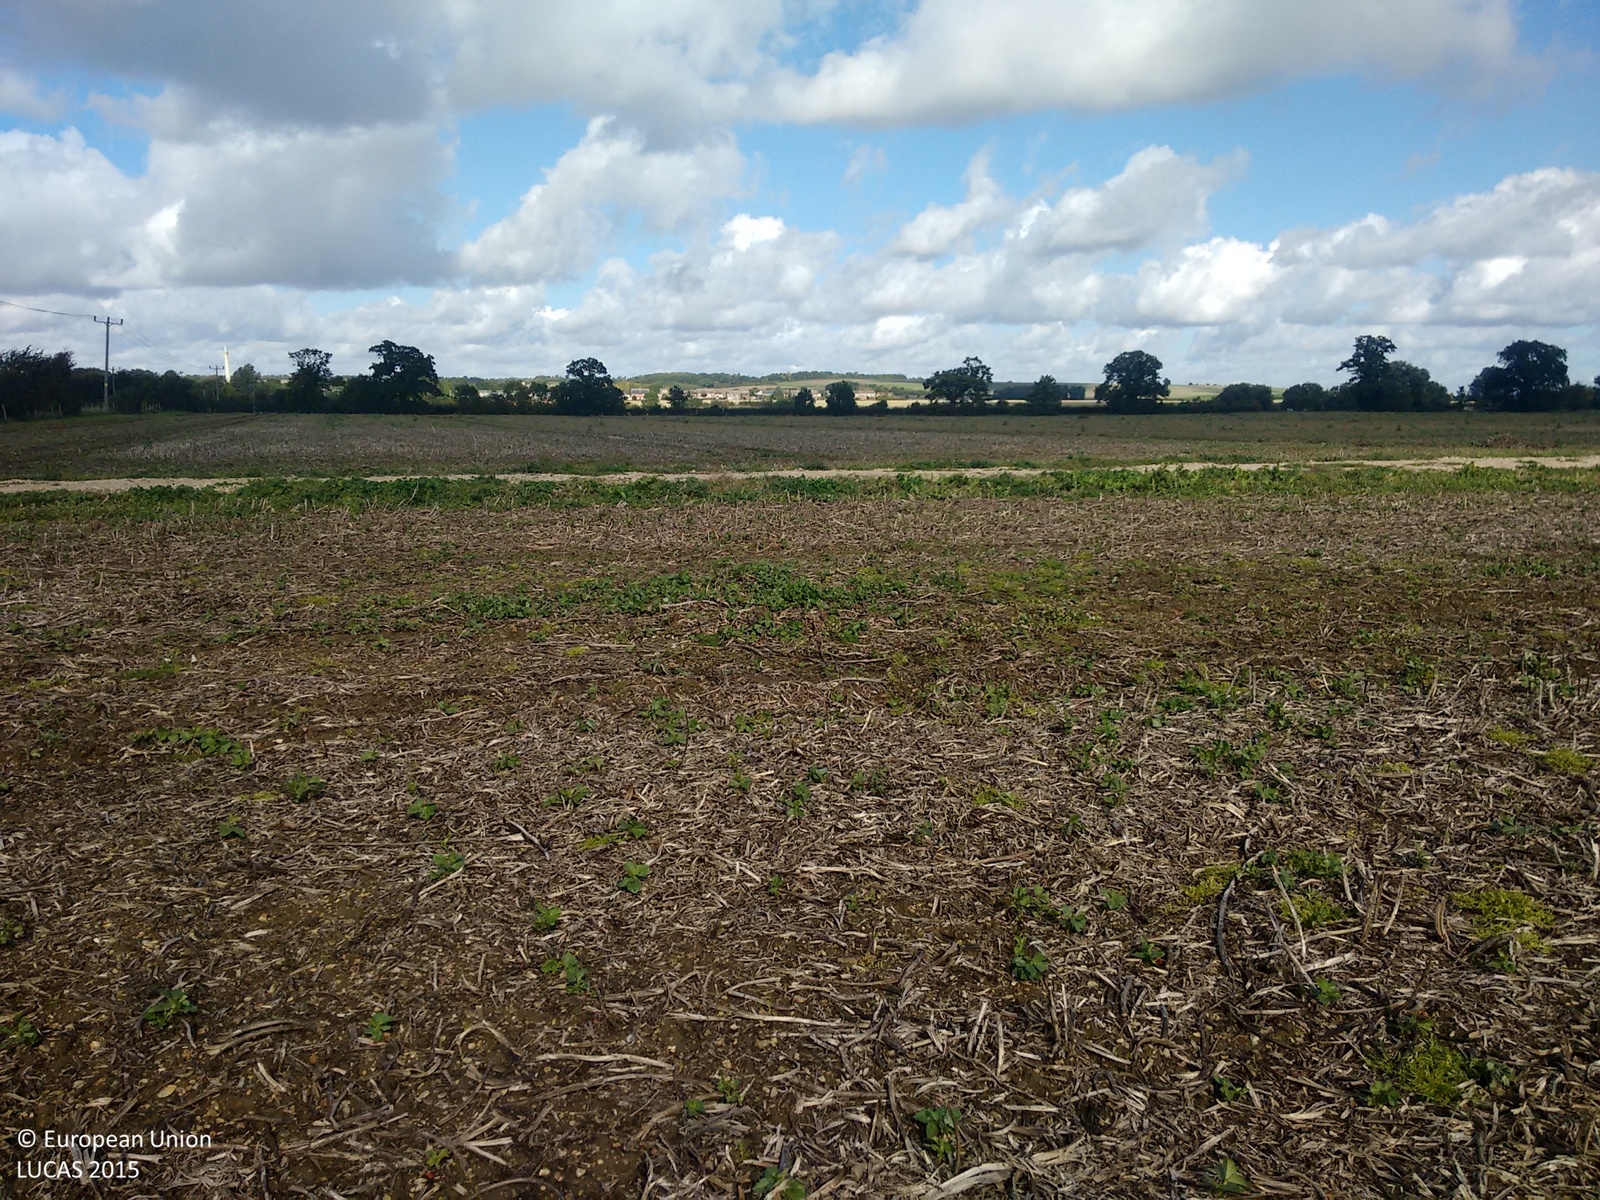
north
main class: Cropland
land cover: Dry pulses
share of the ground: 50 - 75 %
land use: Agriculture (excluding fallow land and kitchen gardens)
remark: Harvested field
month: September
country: GB
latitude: 52.1216
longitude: 0.0507
